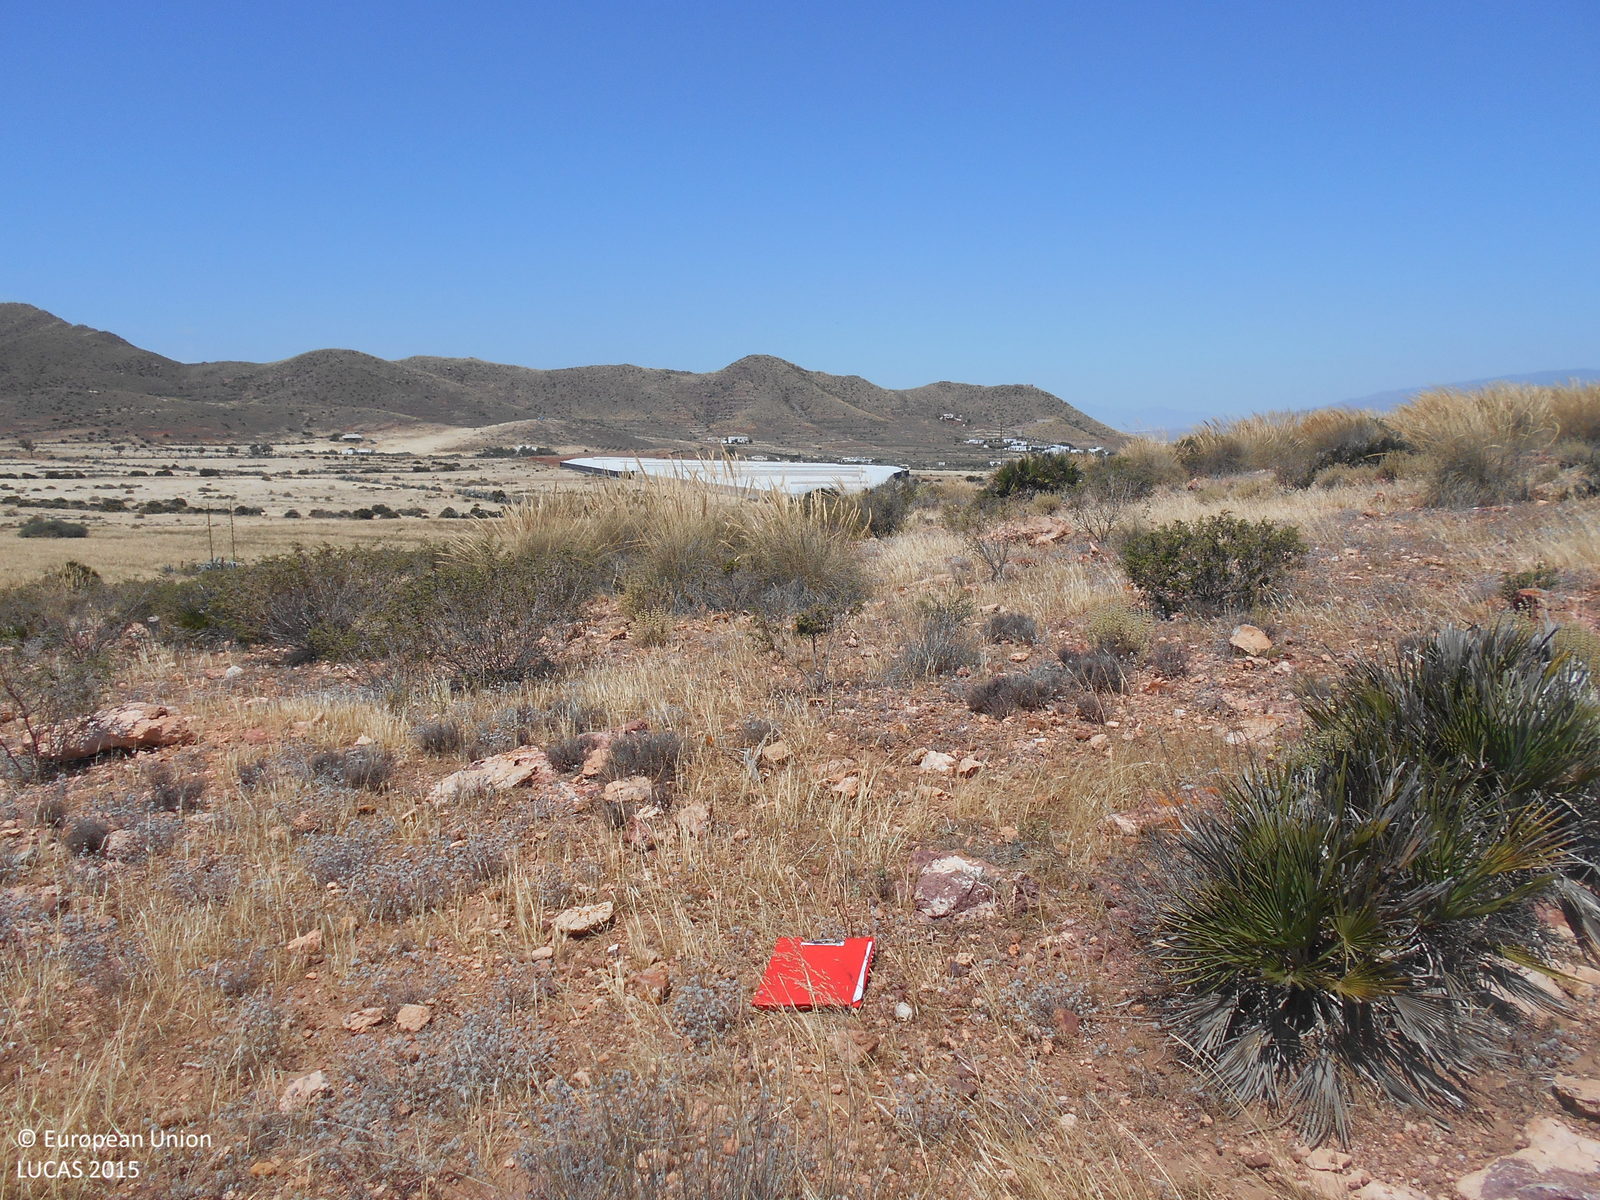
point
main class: Shrubland
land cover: Shrubland without tree cover
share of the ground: 10 - 25 %
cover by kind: unconsolidated bare surface 40 %, herbaceous plants 30 %, shrubs 20 %, consolidated bare surface 10 %
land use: Semi-natural and natural areas not in use
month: May
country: ES
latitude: 36.8026
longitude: -2.1335
